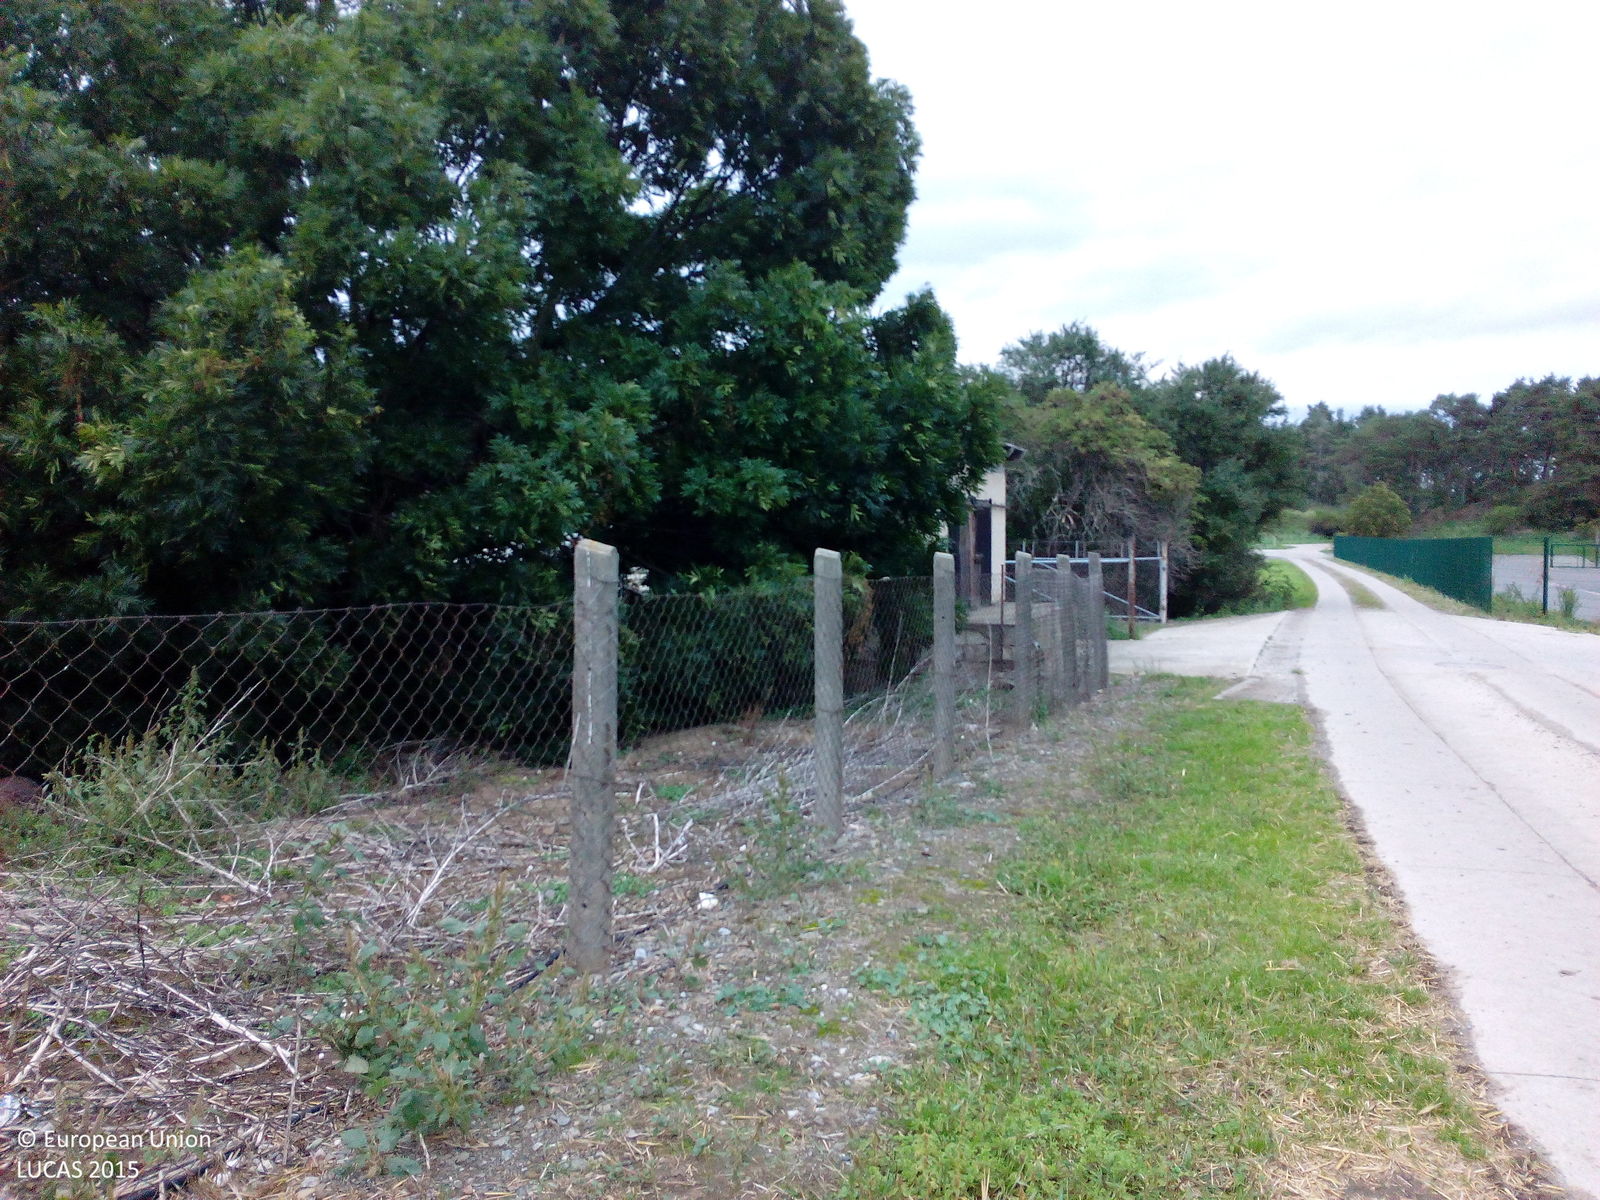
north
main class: Shrubland
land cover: Shrubland without tree cover
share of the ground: > 75 %
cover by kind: shrubs 90 %, herbaceous plants 10 %
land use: Semi-natural and natural areas not in use
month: September
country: DE
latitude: 51.8158
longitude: 11.0296
